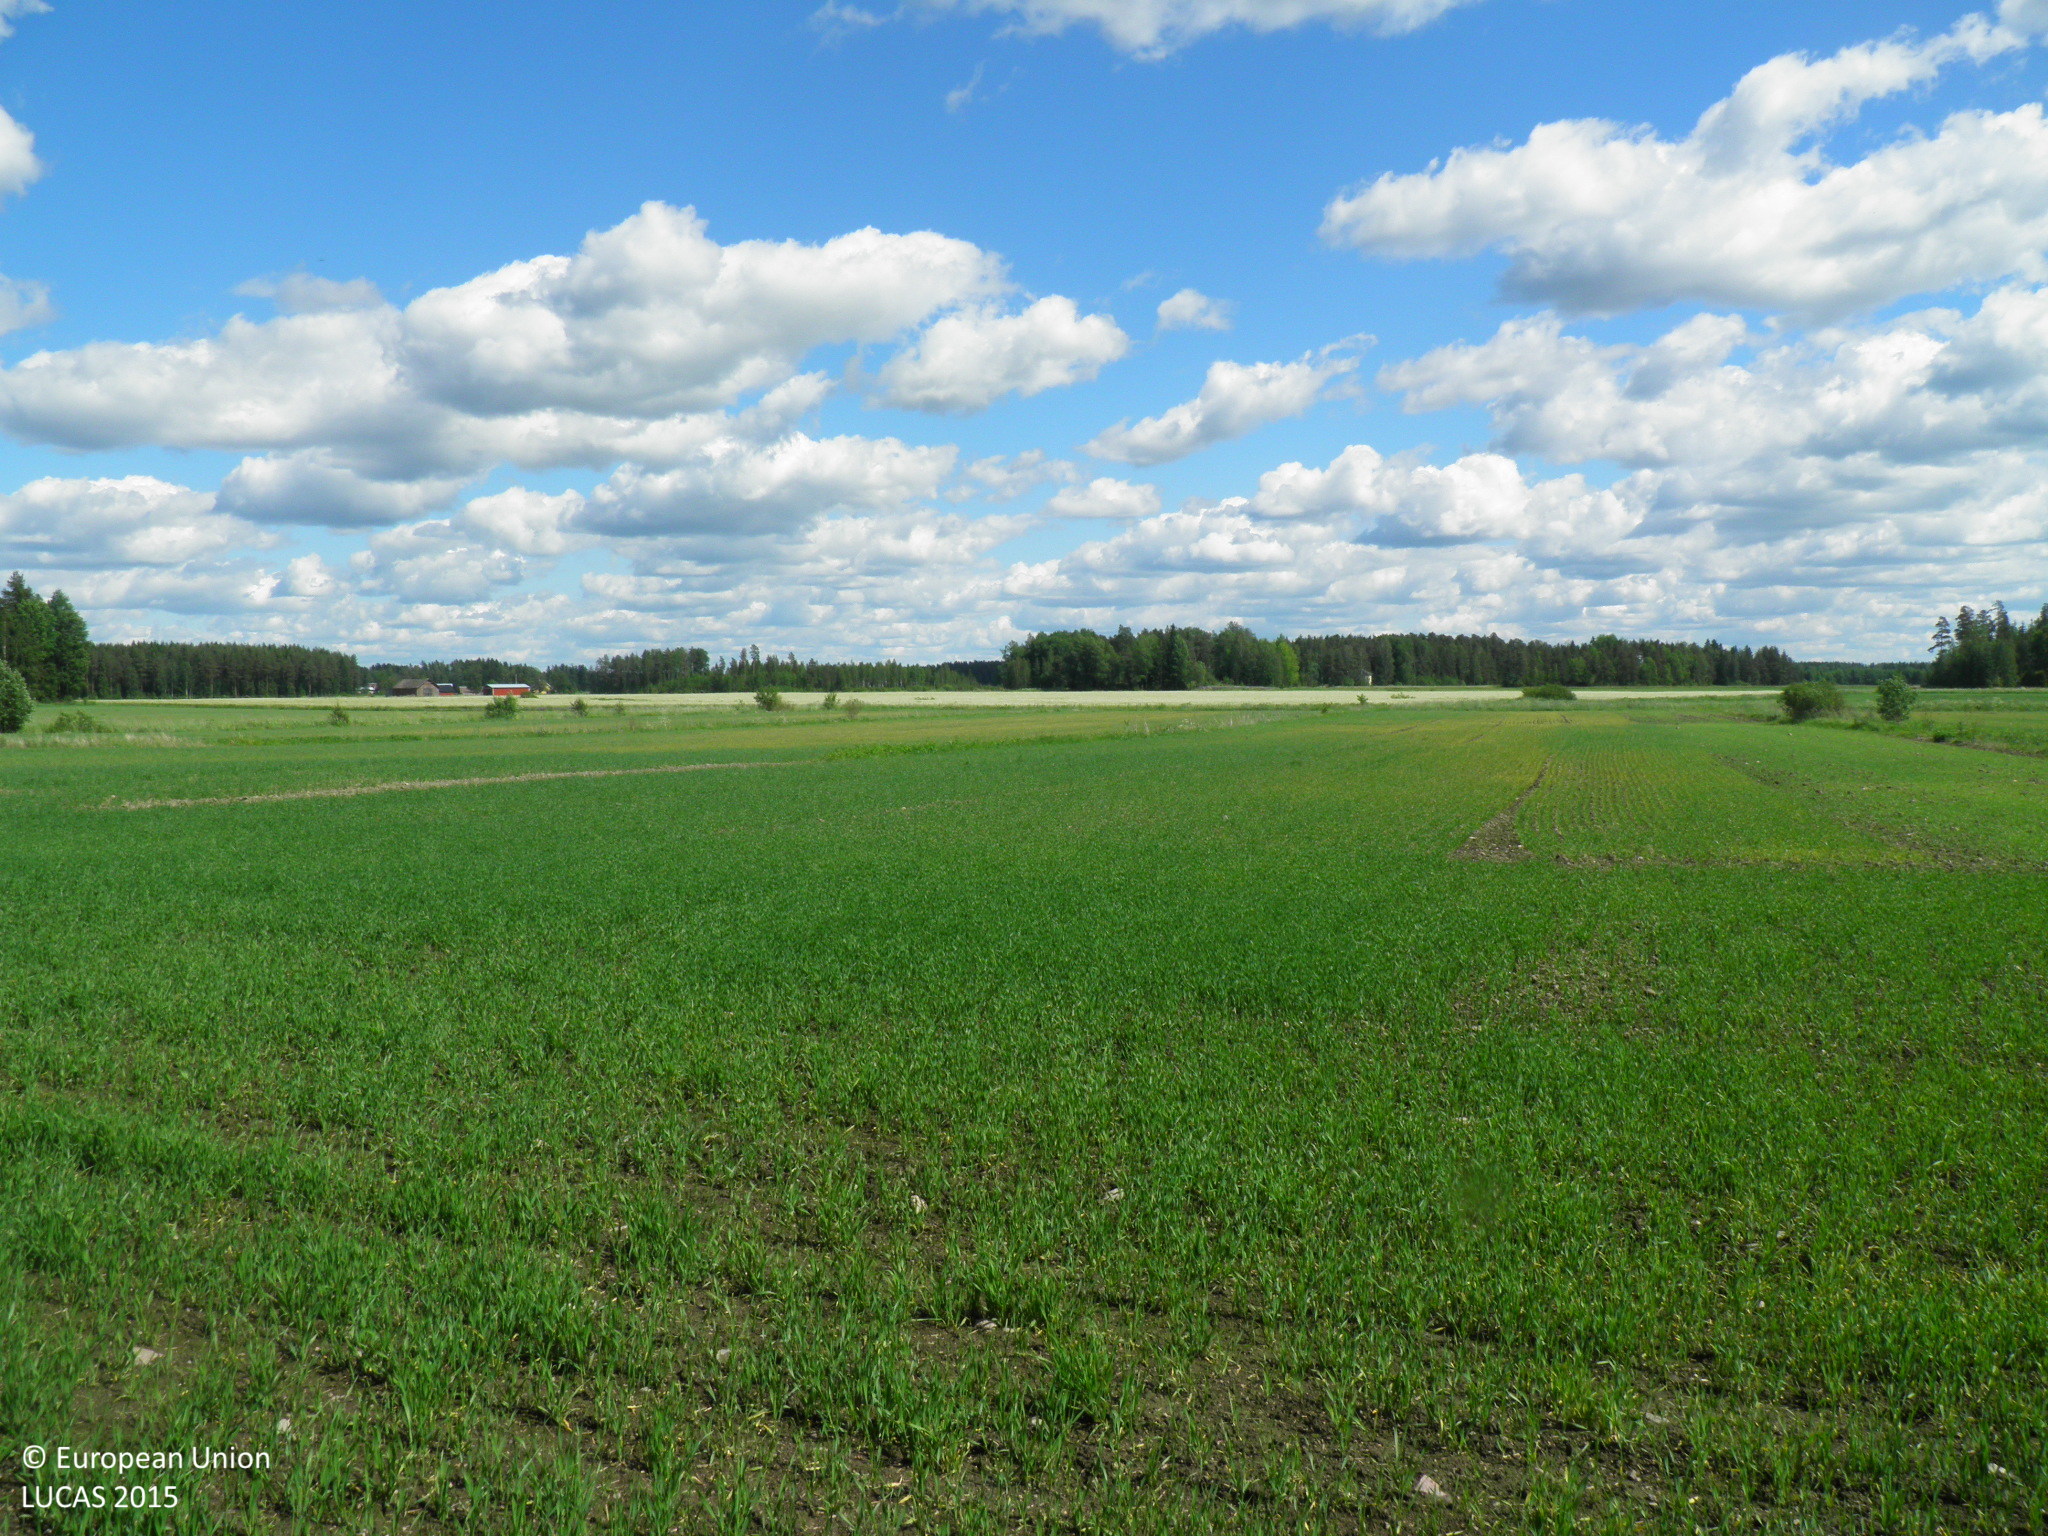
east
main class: Cropland
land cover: Barley
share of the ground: > 75 %
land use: Agriculture (excluding fallow land and kitchen gardens)
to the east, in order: Barley; Ditches and canals; Barley; Grass margins; Ditches and canals; Grass margins; Barley; Grass margins; Ditches and canals; Grass margins; Other cereals
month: June
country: FI
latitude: 60.5111
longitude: 22.7679
